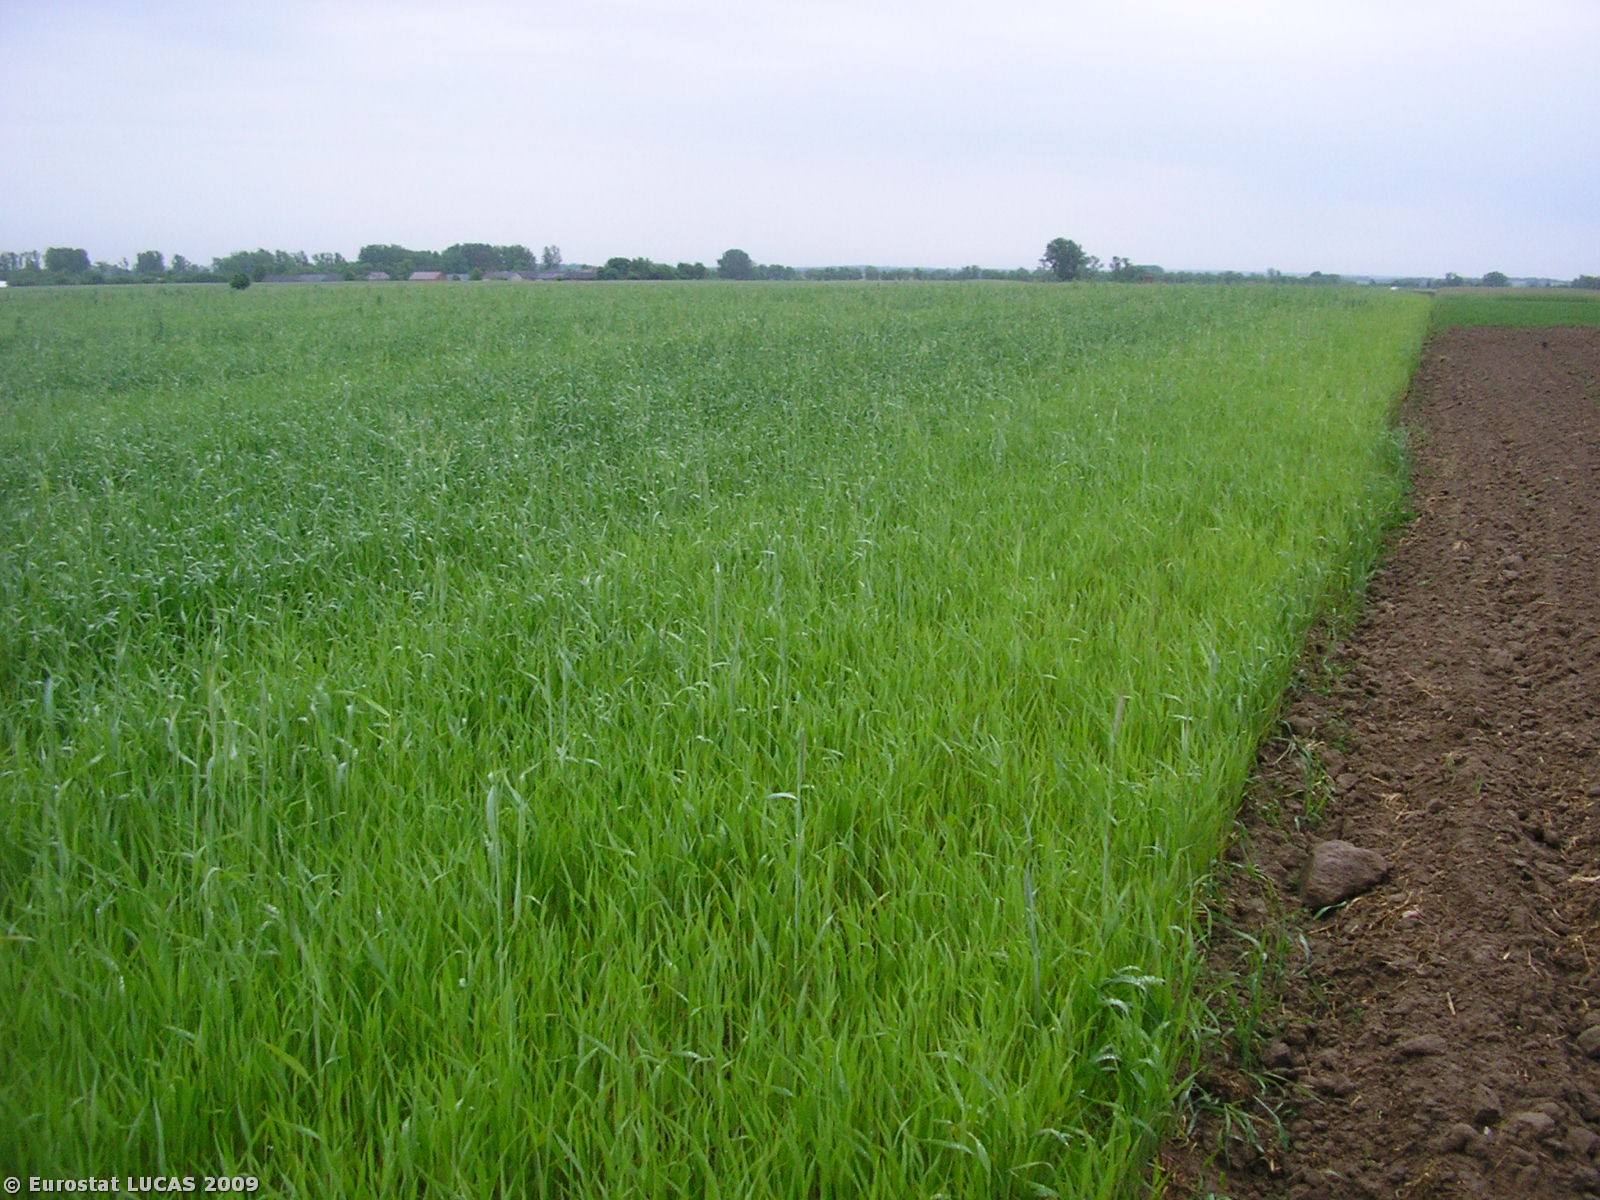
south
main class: Cropland
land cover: Triticale
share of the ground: > 75 %
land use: Agriculture (excluding fallow land and kitchen gardens)
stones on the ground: < 10 %
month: May
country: PL
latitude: 51.8248
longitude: 20.0299
